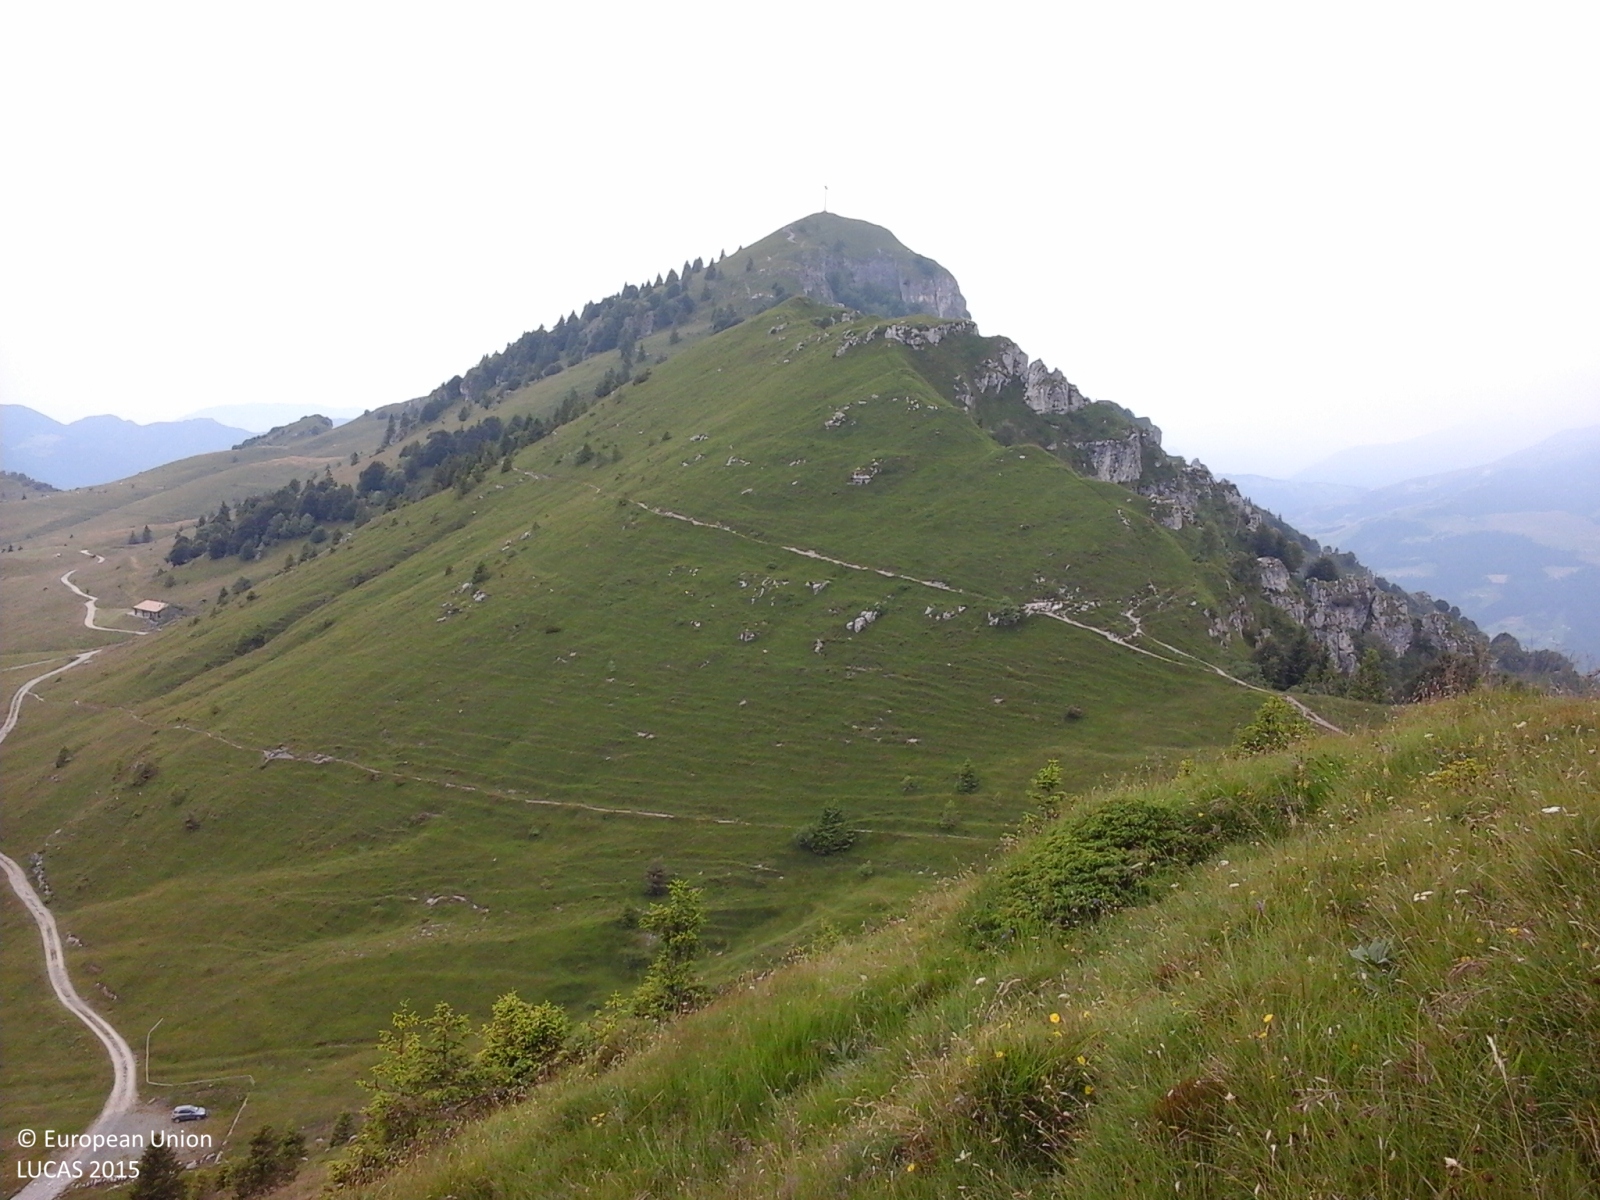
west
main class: Grassland
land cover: Grassland with sparse tree/shrub cover
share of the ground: > 75 %
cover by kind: herbaceous plants 90 %, coniferous forest trees 5 %, shrubs 5 %
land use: Agriculture (excluding fallow land and kitchen gardens)
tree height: < 5 m
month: June
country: IT
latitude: 45.8468
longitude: 9.9357
